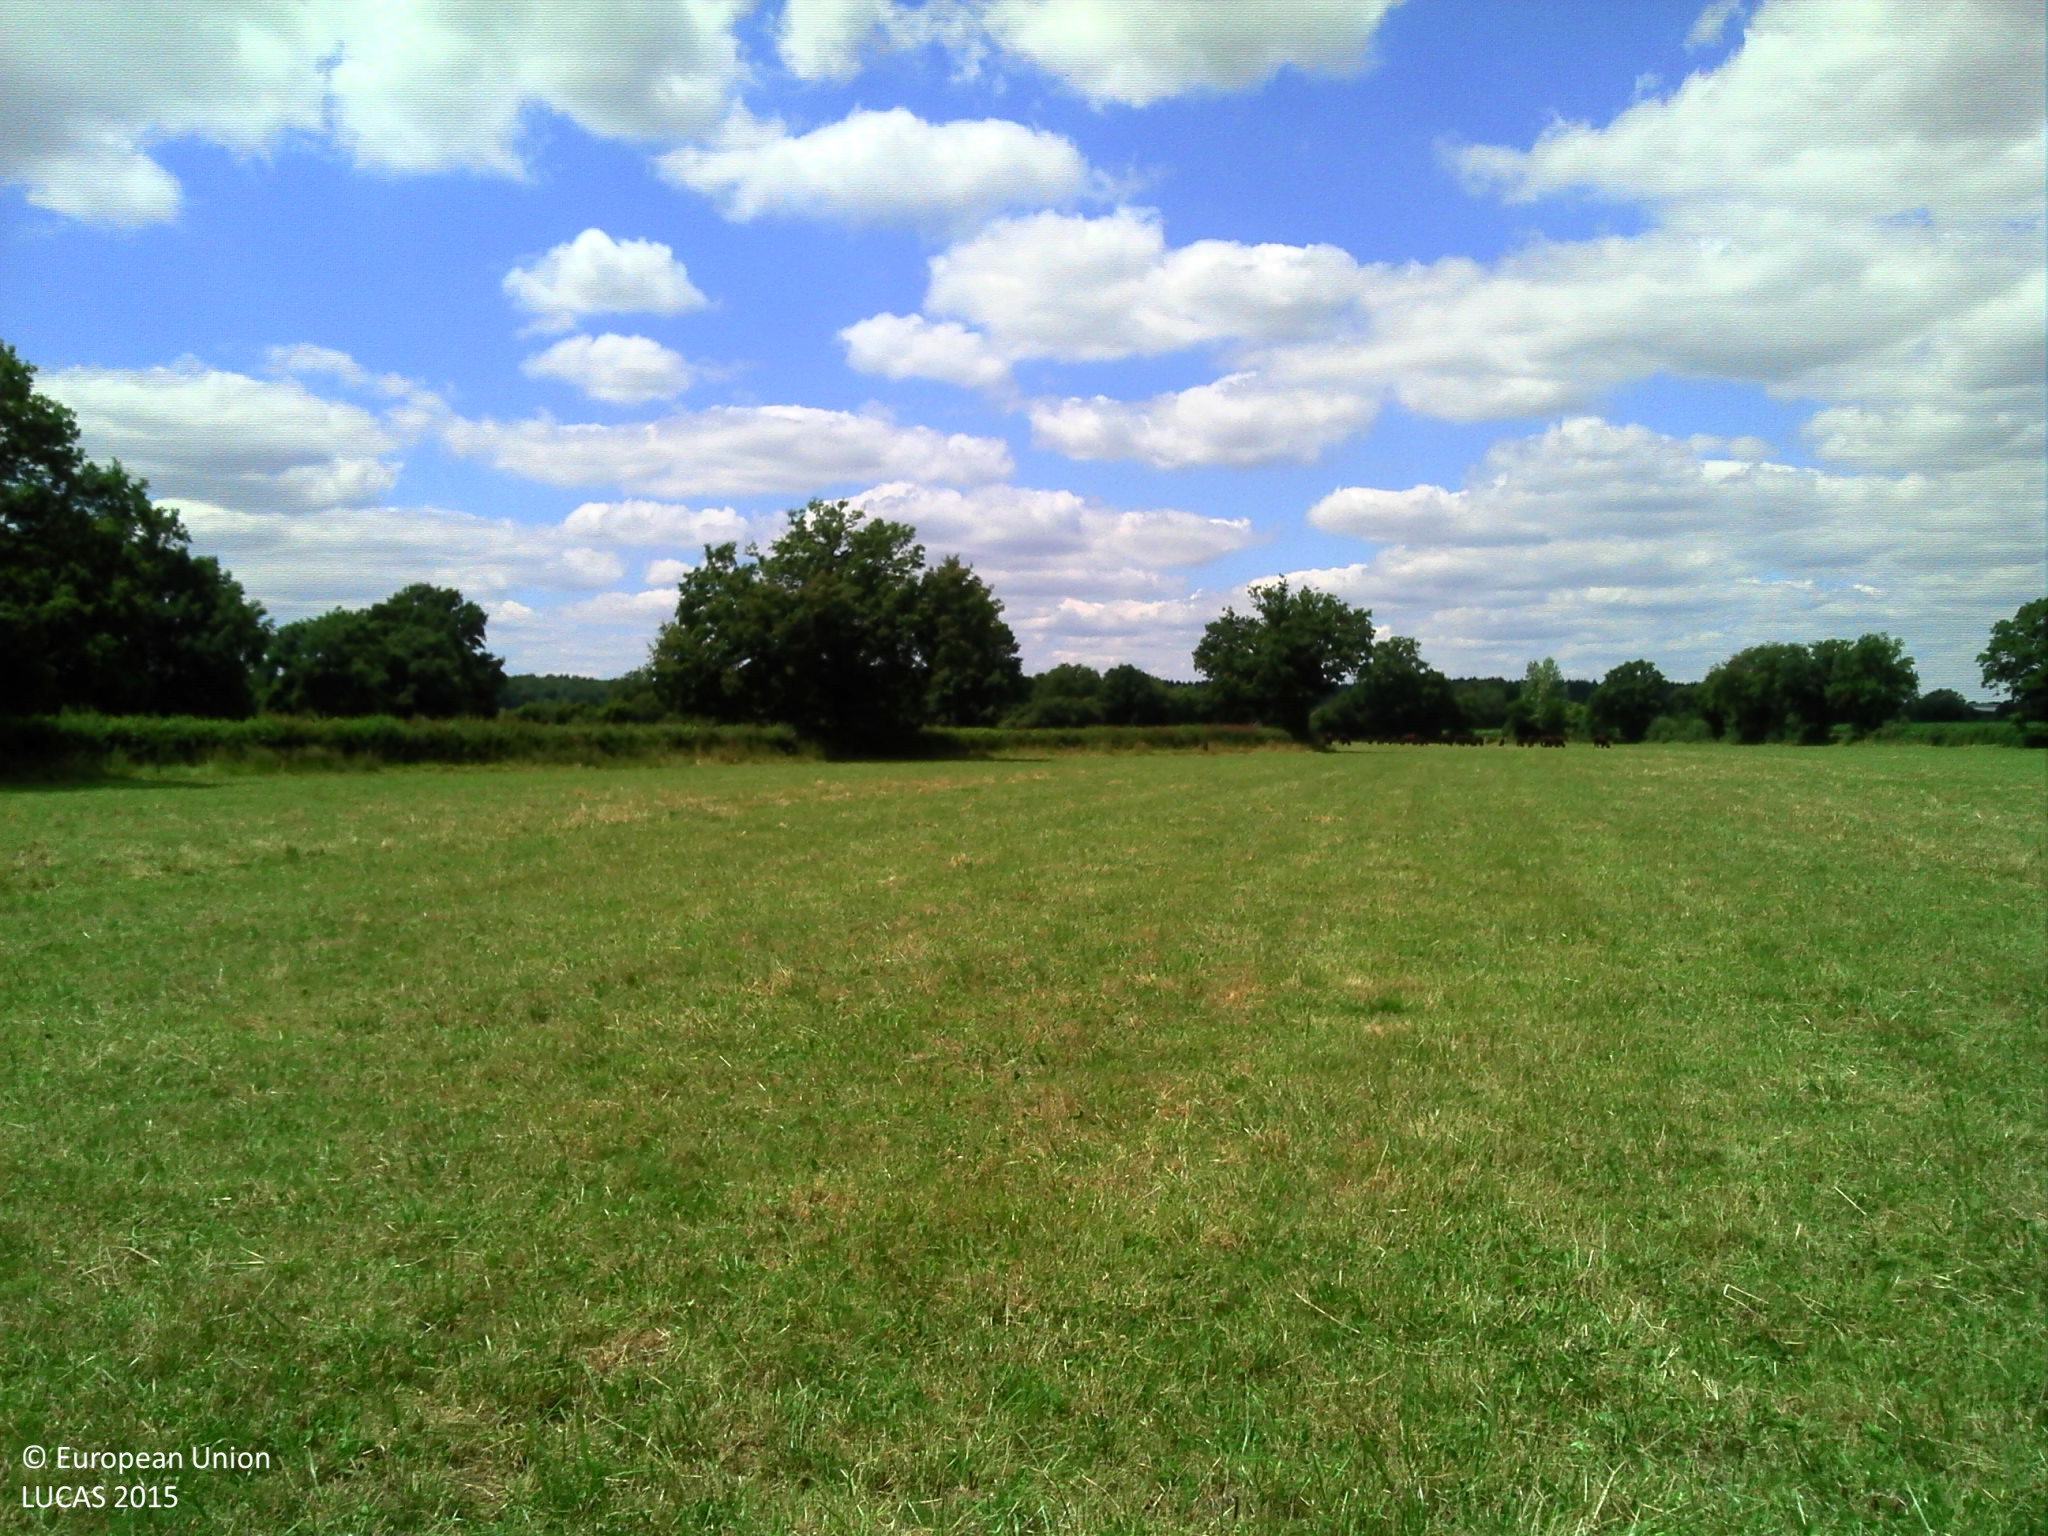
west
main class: Grassland
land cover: Grassland without tree/shrub cover
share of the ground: > 75 %
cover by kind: herbaceous plants 100 %
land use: Agriculture (excluding fallow land and kitchen gardens)
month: June
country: FR
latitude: 46.6509
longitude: 3.6617
